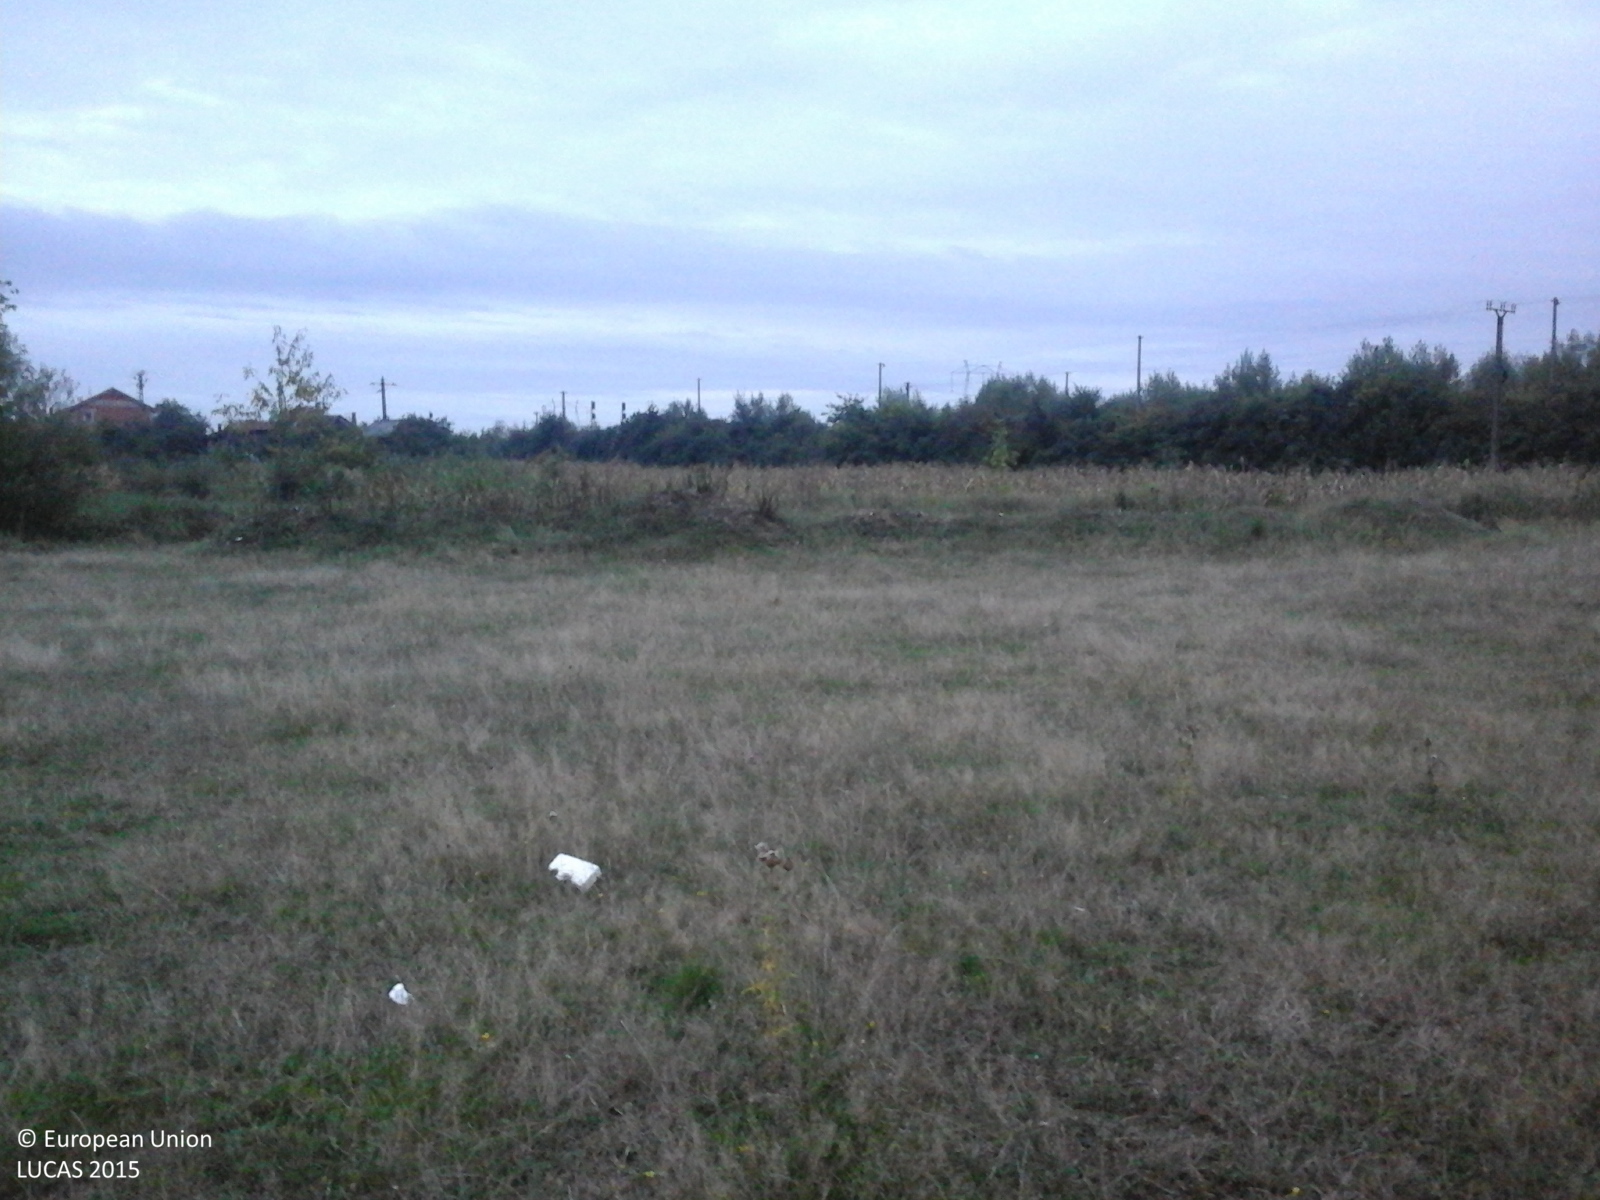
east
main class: Grassland
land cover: Grassland without tree/shrub cover
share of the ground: > 75 %
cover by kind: herbaceous plants 100 %
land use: Agriculture (excluding fallow land and kitchen gardens)
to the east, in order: Grassland without tree/shrub cover; Fences; Lucerne; Abandoned hedges; Maize; Artificial constructions in urban areas; Maize; Grassland without tree/shrub cover
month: September
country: RO
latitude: 47.0366
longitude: 22.0099
